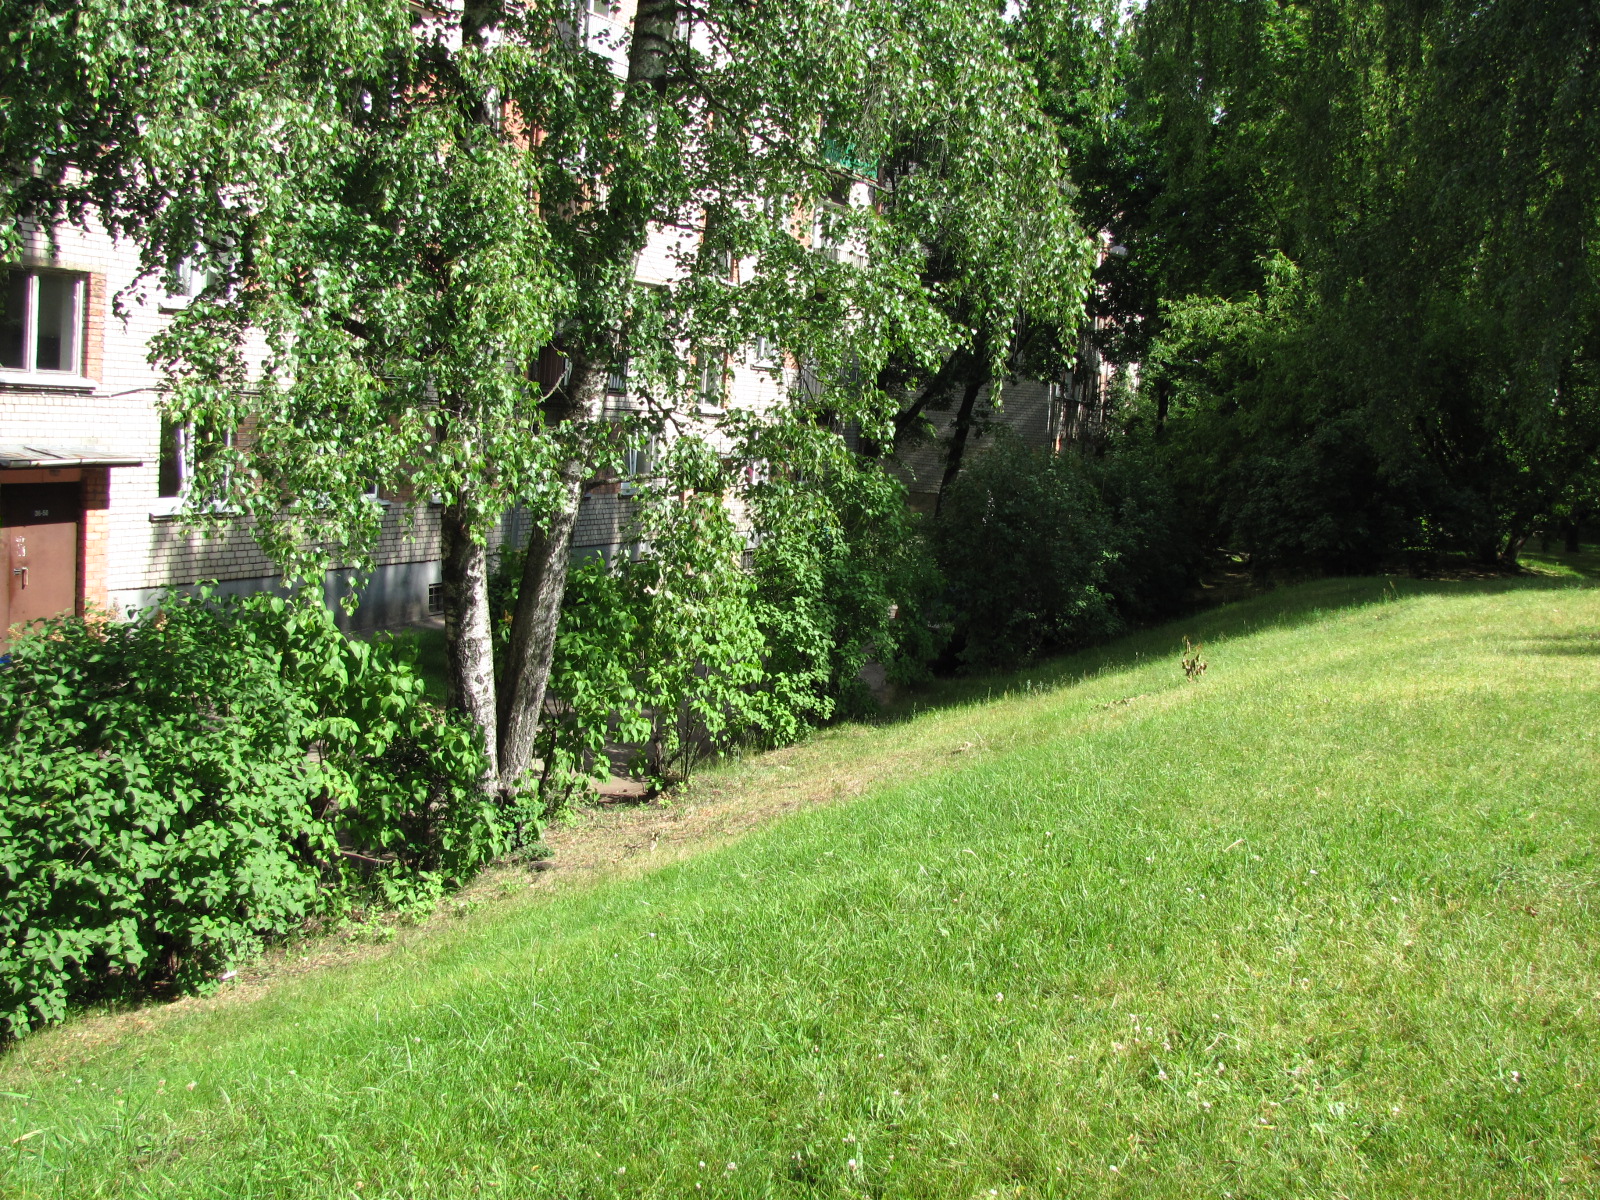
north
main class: Grassland
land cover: Grassland with sparse tree/shrub cover
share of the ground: > 75 %
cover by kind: herbaceous plants 95 %, broadleaved forest trees 5 %
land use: Residential
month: June
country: LV
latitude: 56.9642
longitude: 24.0474
